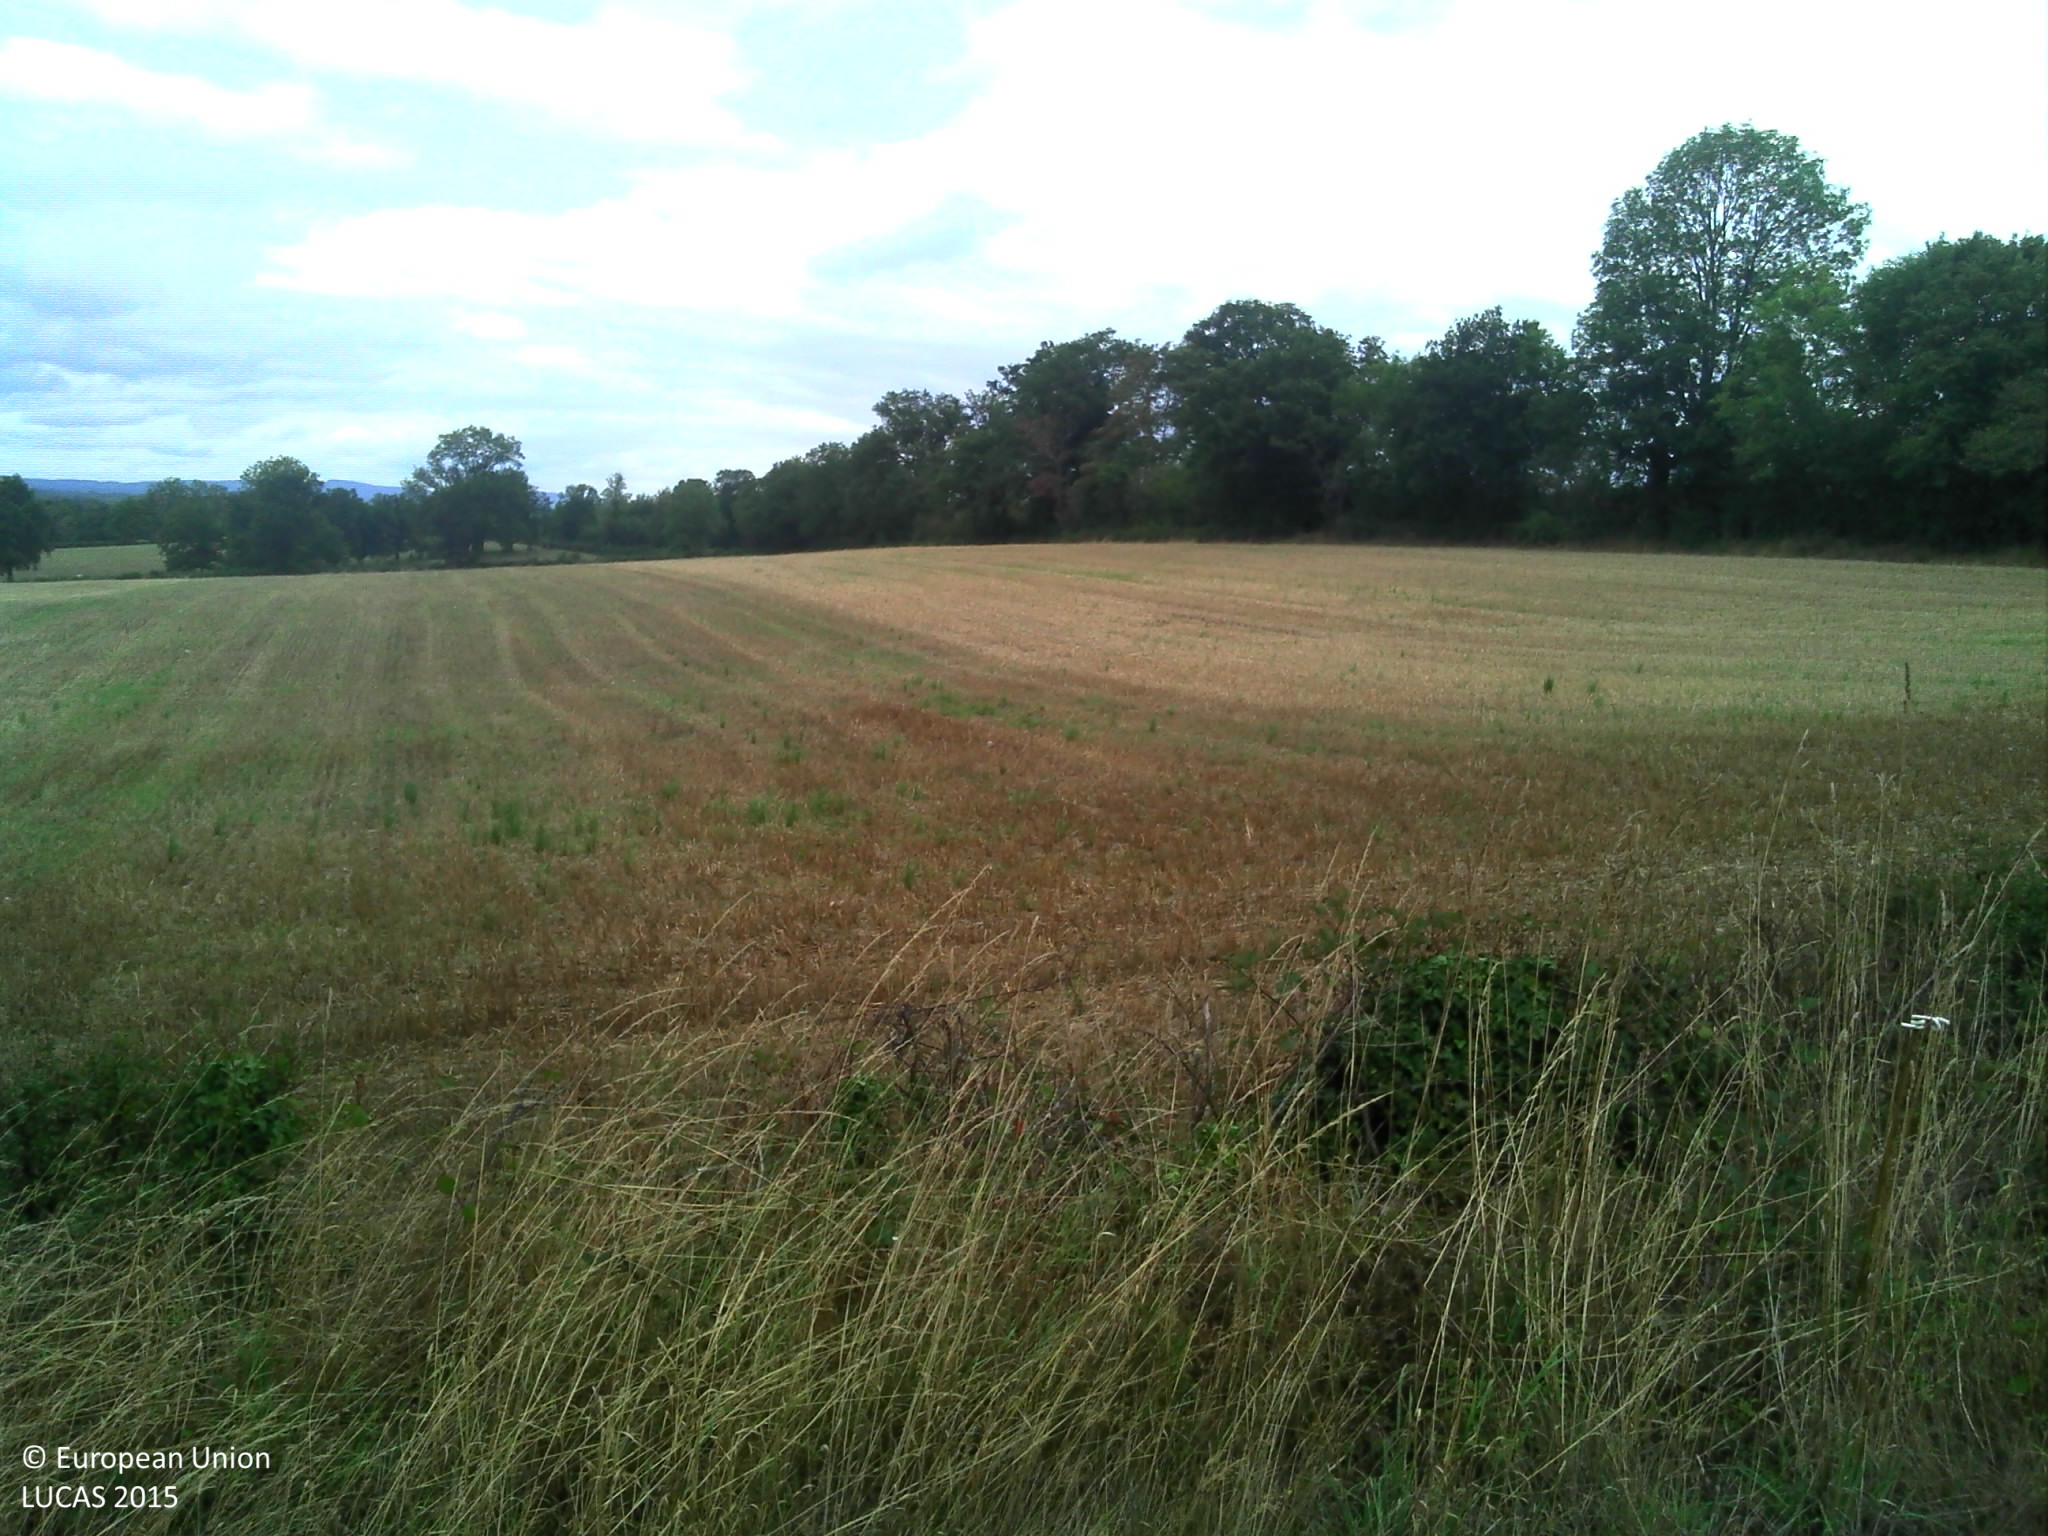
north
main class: Grassland
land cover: Grassland without tree/shrub cover
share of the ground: > 75 %
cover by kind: herbaceous plants 100 %
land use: Agriculture (excluding fallow land and kitchen gardens)
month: August
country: FR
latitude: 46.1075
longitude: 2.2716
